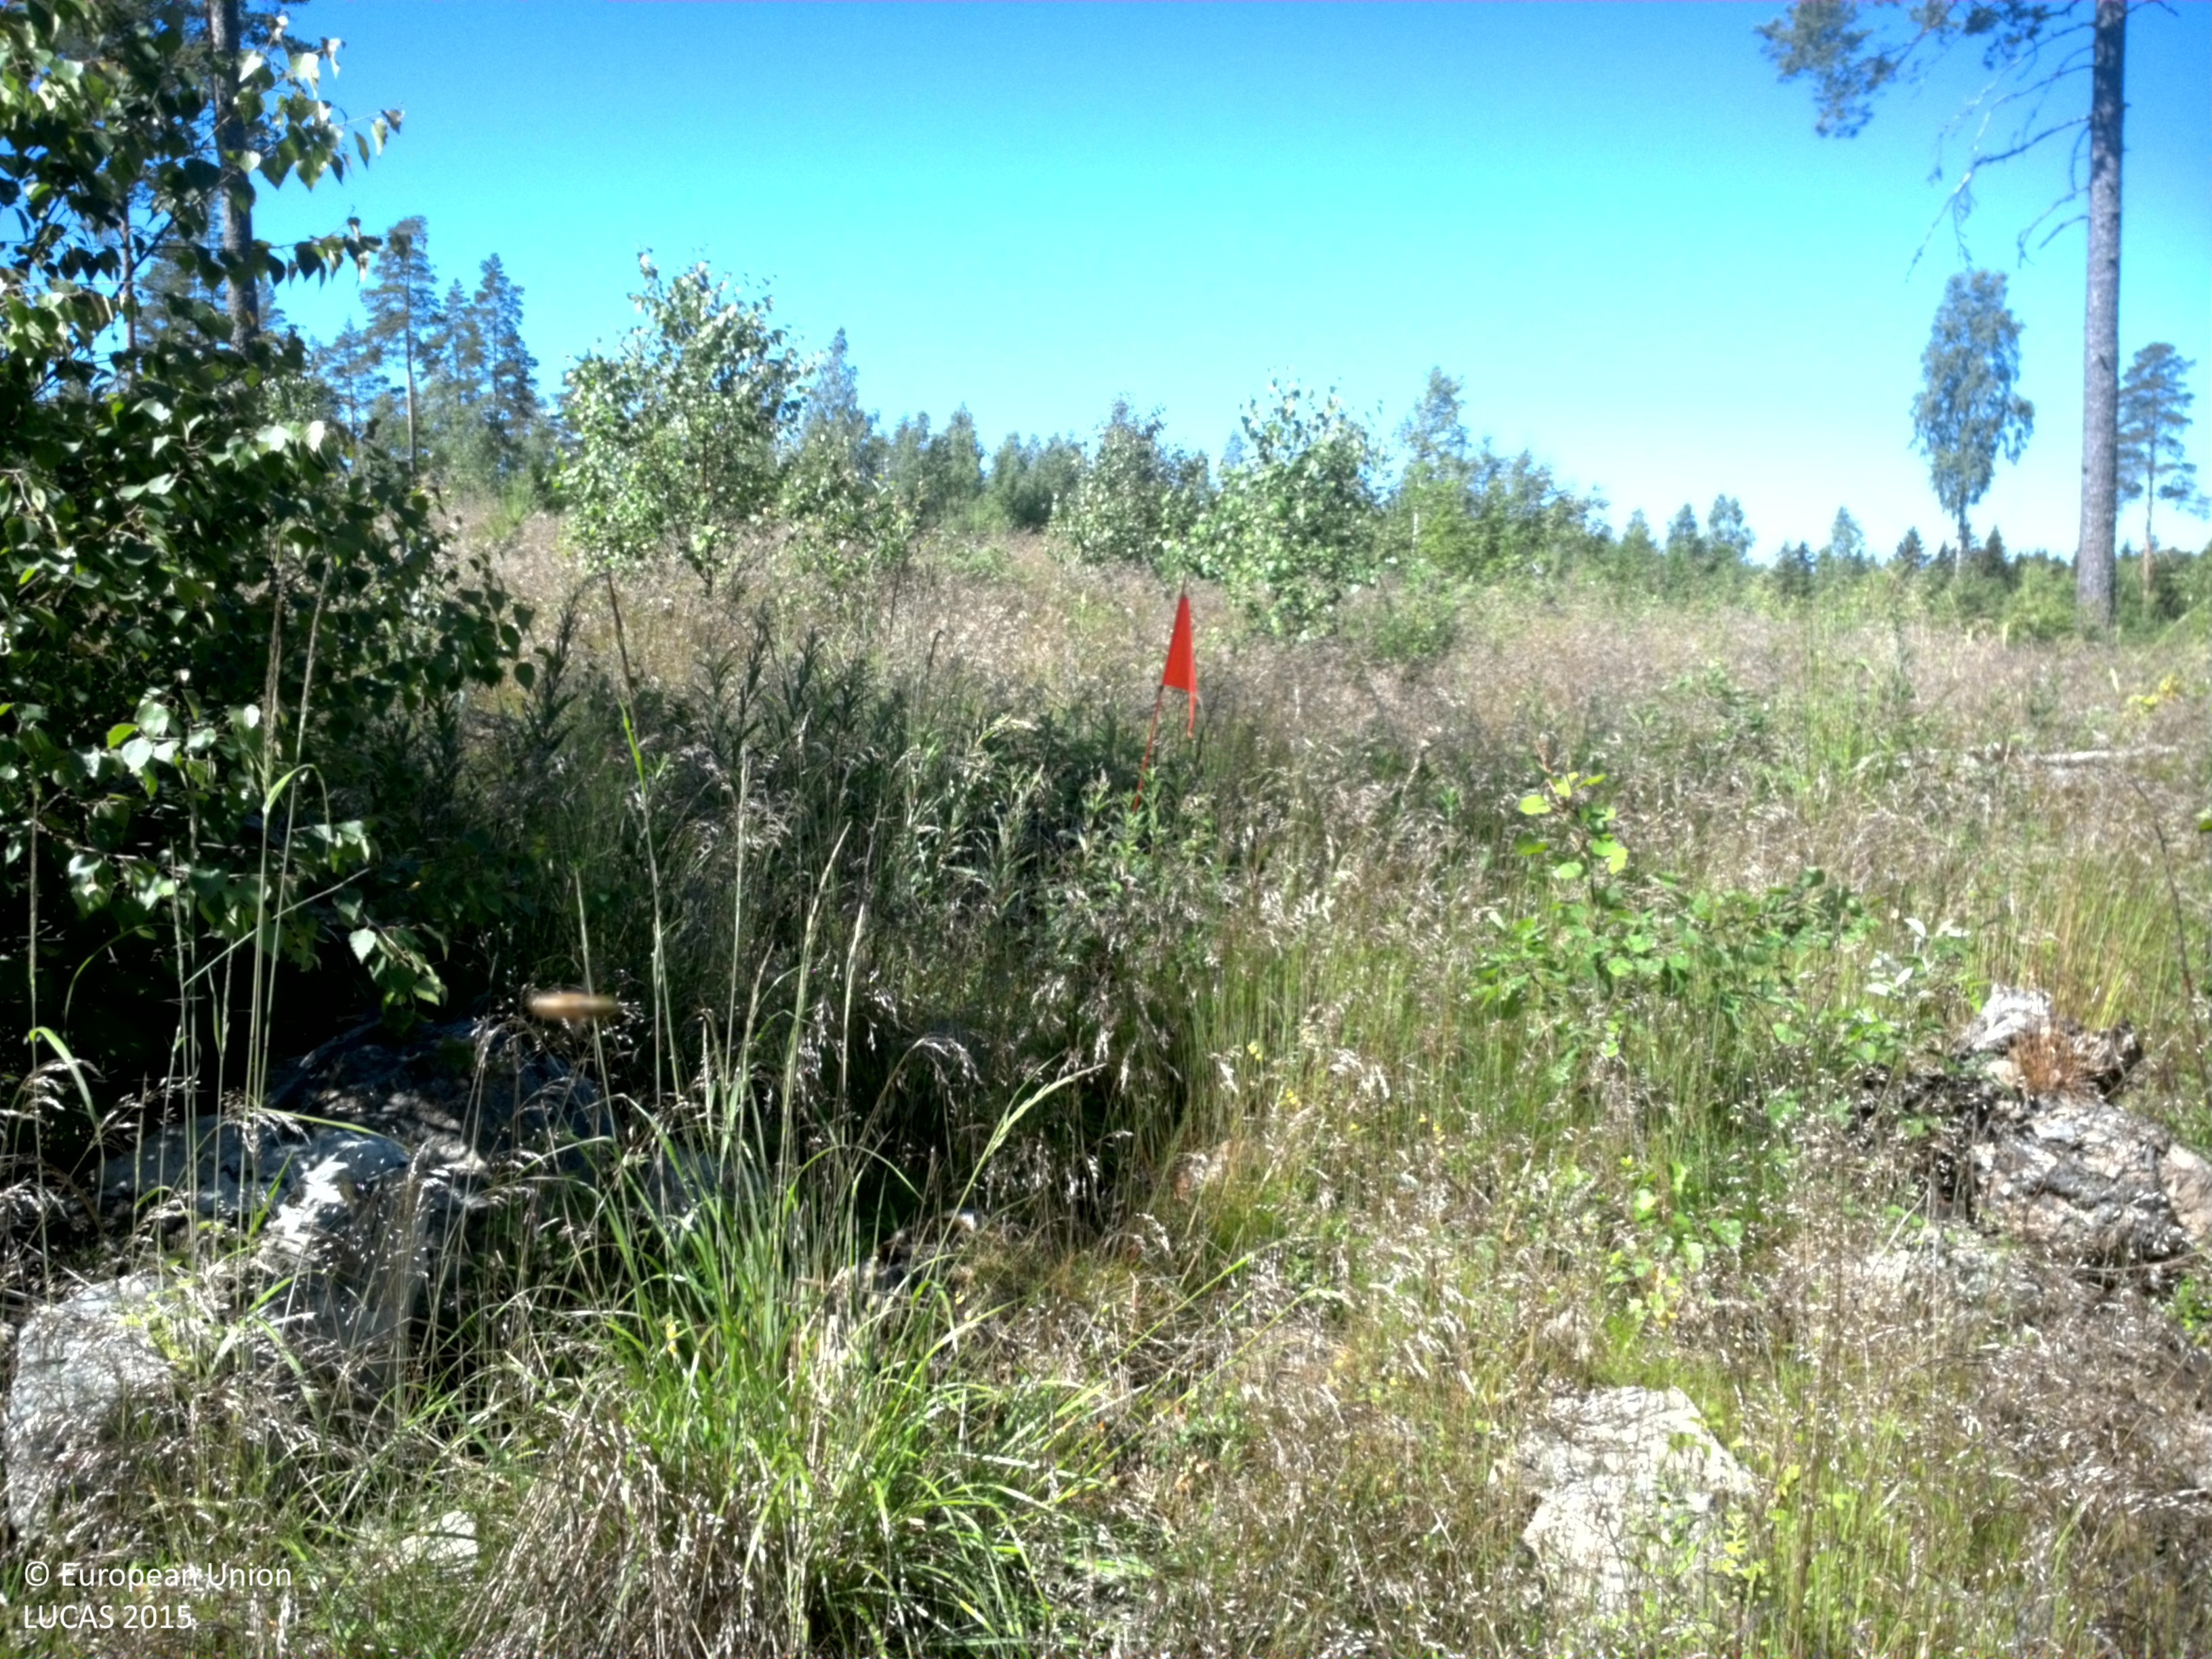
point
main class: Woodland
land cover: Broadleaved woodland
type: hemiboreal forest and nemoral coniferous forest and mixed broadleaved-coniferous forest
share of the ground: 10 - 25 %
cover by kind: herbaceous plants 70 %, broadleaved forest trees 20 %, coniferous forest trees 5 %, consolidated bare surface 5 %
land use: Forestry
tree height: < 5 m
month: July
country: SE
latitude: 60.0384
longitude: 16.7225
